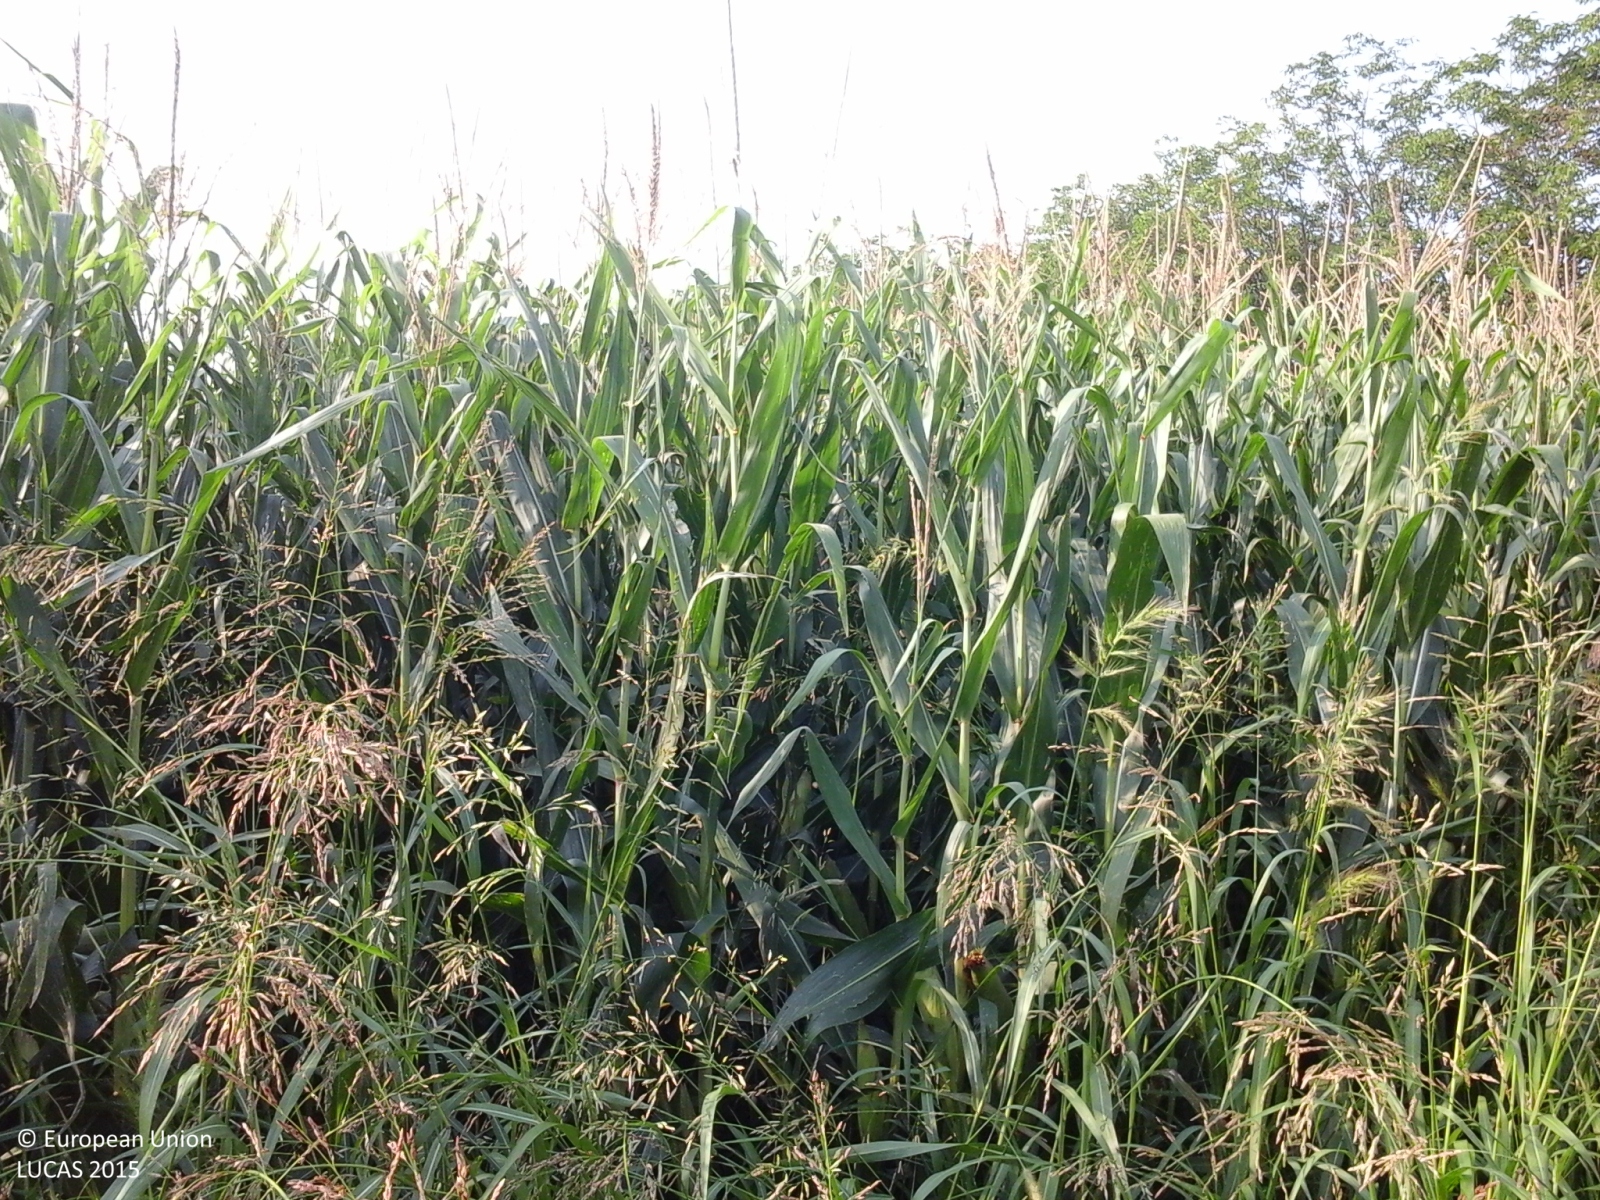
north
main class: Cropland
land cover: Maize
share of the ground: > 75 %
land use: Agriculture (excluding fallow land and kitchen gardens)
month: June
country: IT
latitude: 45.9276
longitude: 12.4083
